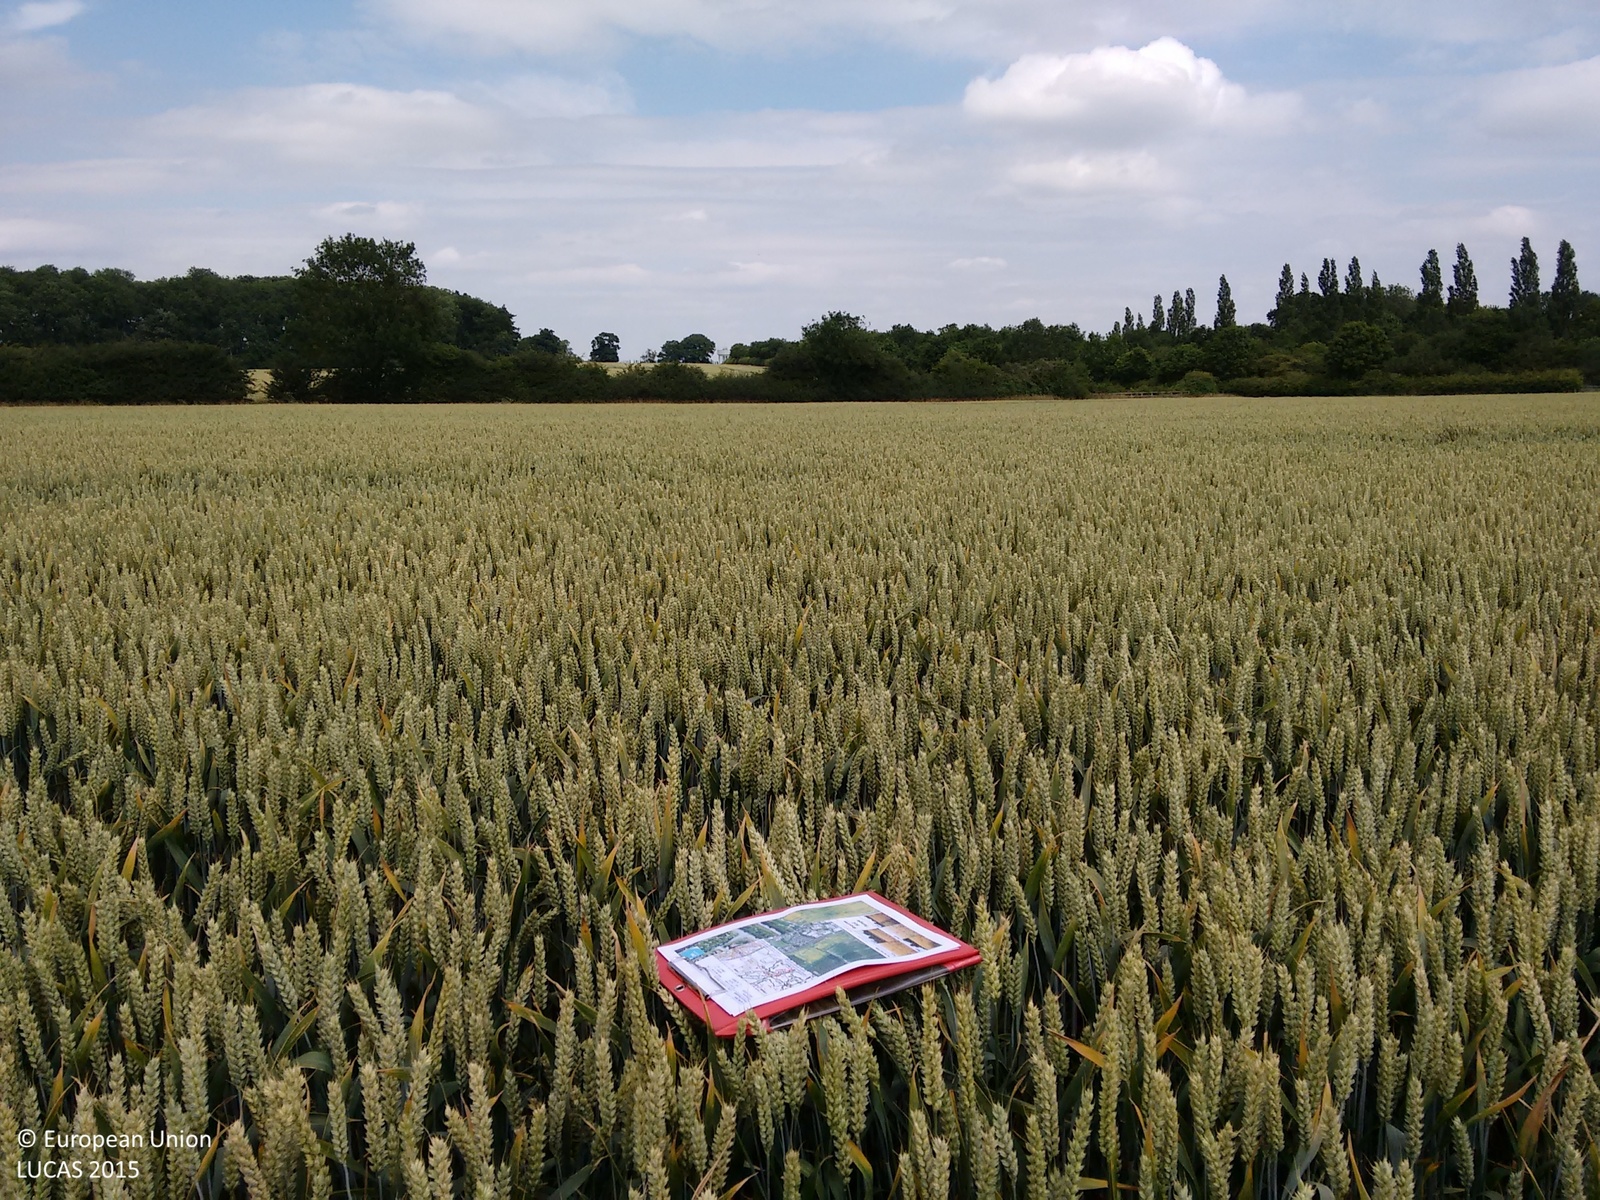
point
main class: Cropland
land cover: Common wheat
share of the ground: > 75 %
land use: Agriculture (excluding fallow land and kitchen gardens)
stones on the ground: < 10 %
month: July
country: GB
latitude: 52.4690
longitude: -0.7427
